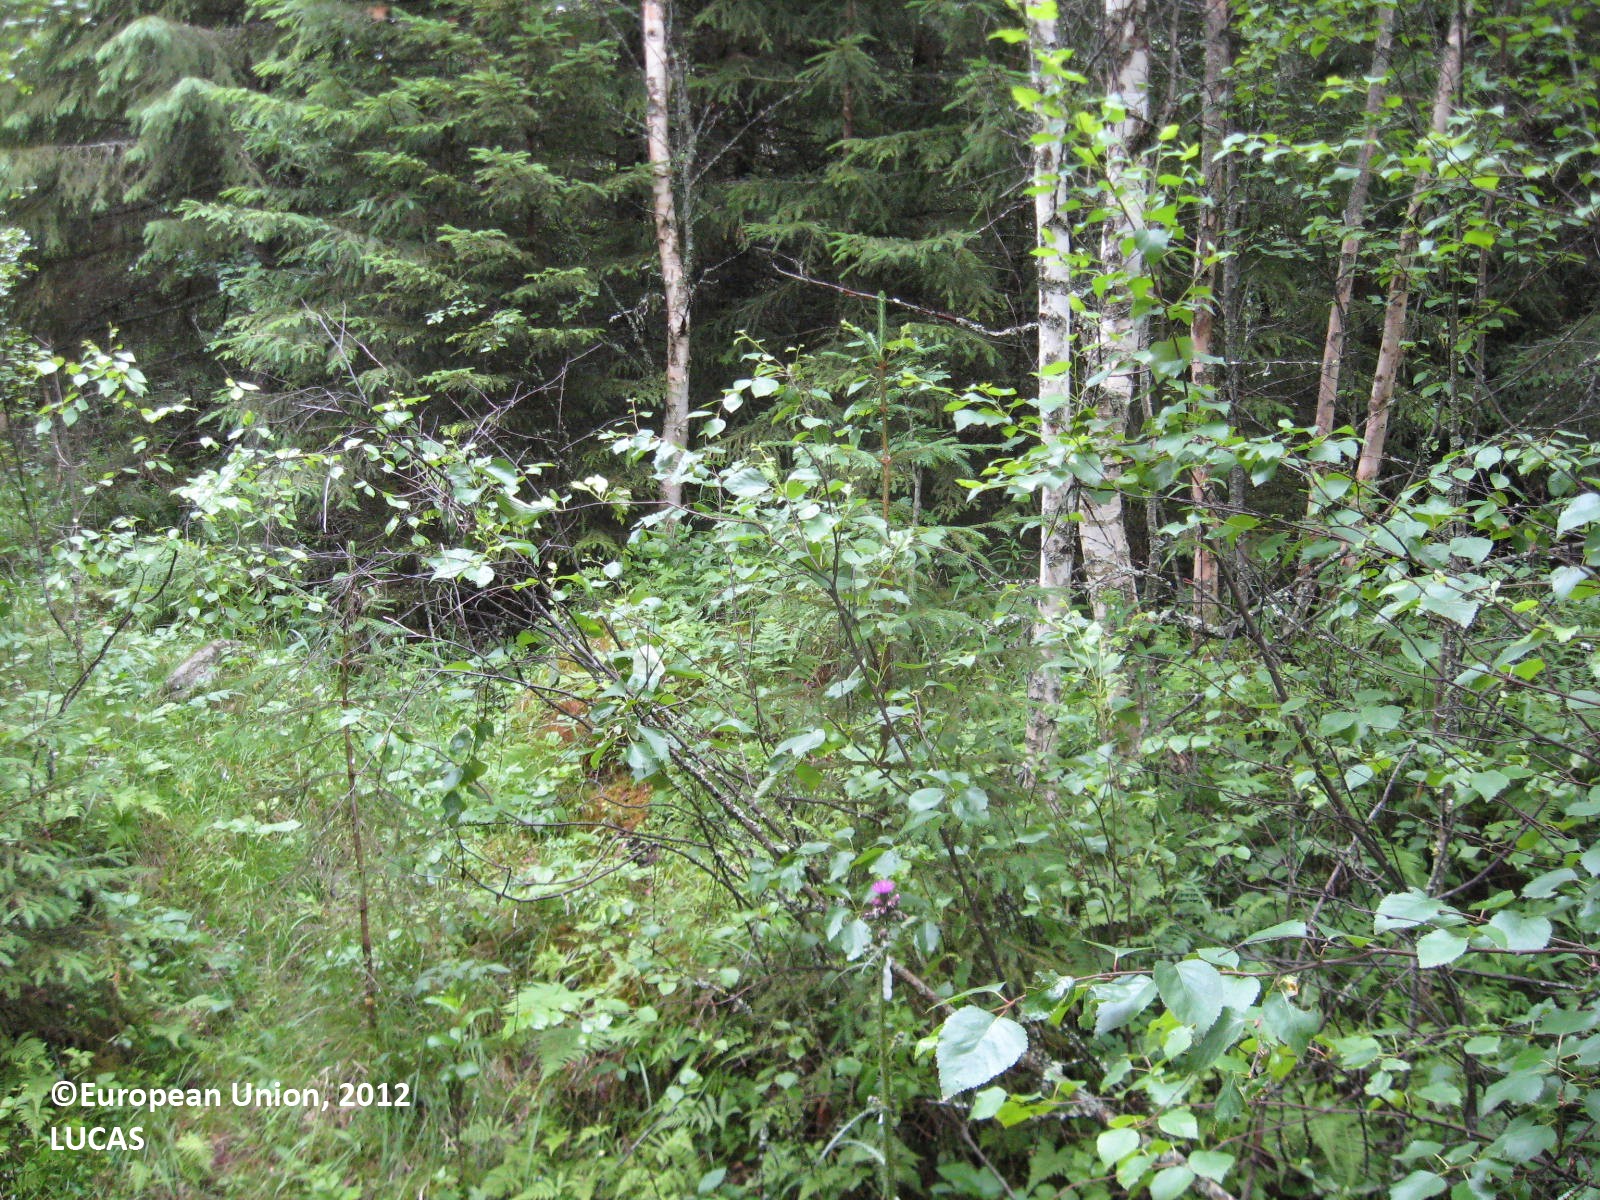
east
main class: Woodland
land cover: Other mixed woodland
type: boreal forest
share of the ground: > 75 %
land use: Forestry
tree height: > 5 m
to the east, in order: Other mixed woodland; Ditches and canals; Other mixed woodland; Spruce dominated mixed woodland
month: July
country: FI
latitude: 62.3942
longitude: 21.6719
